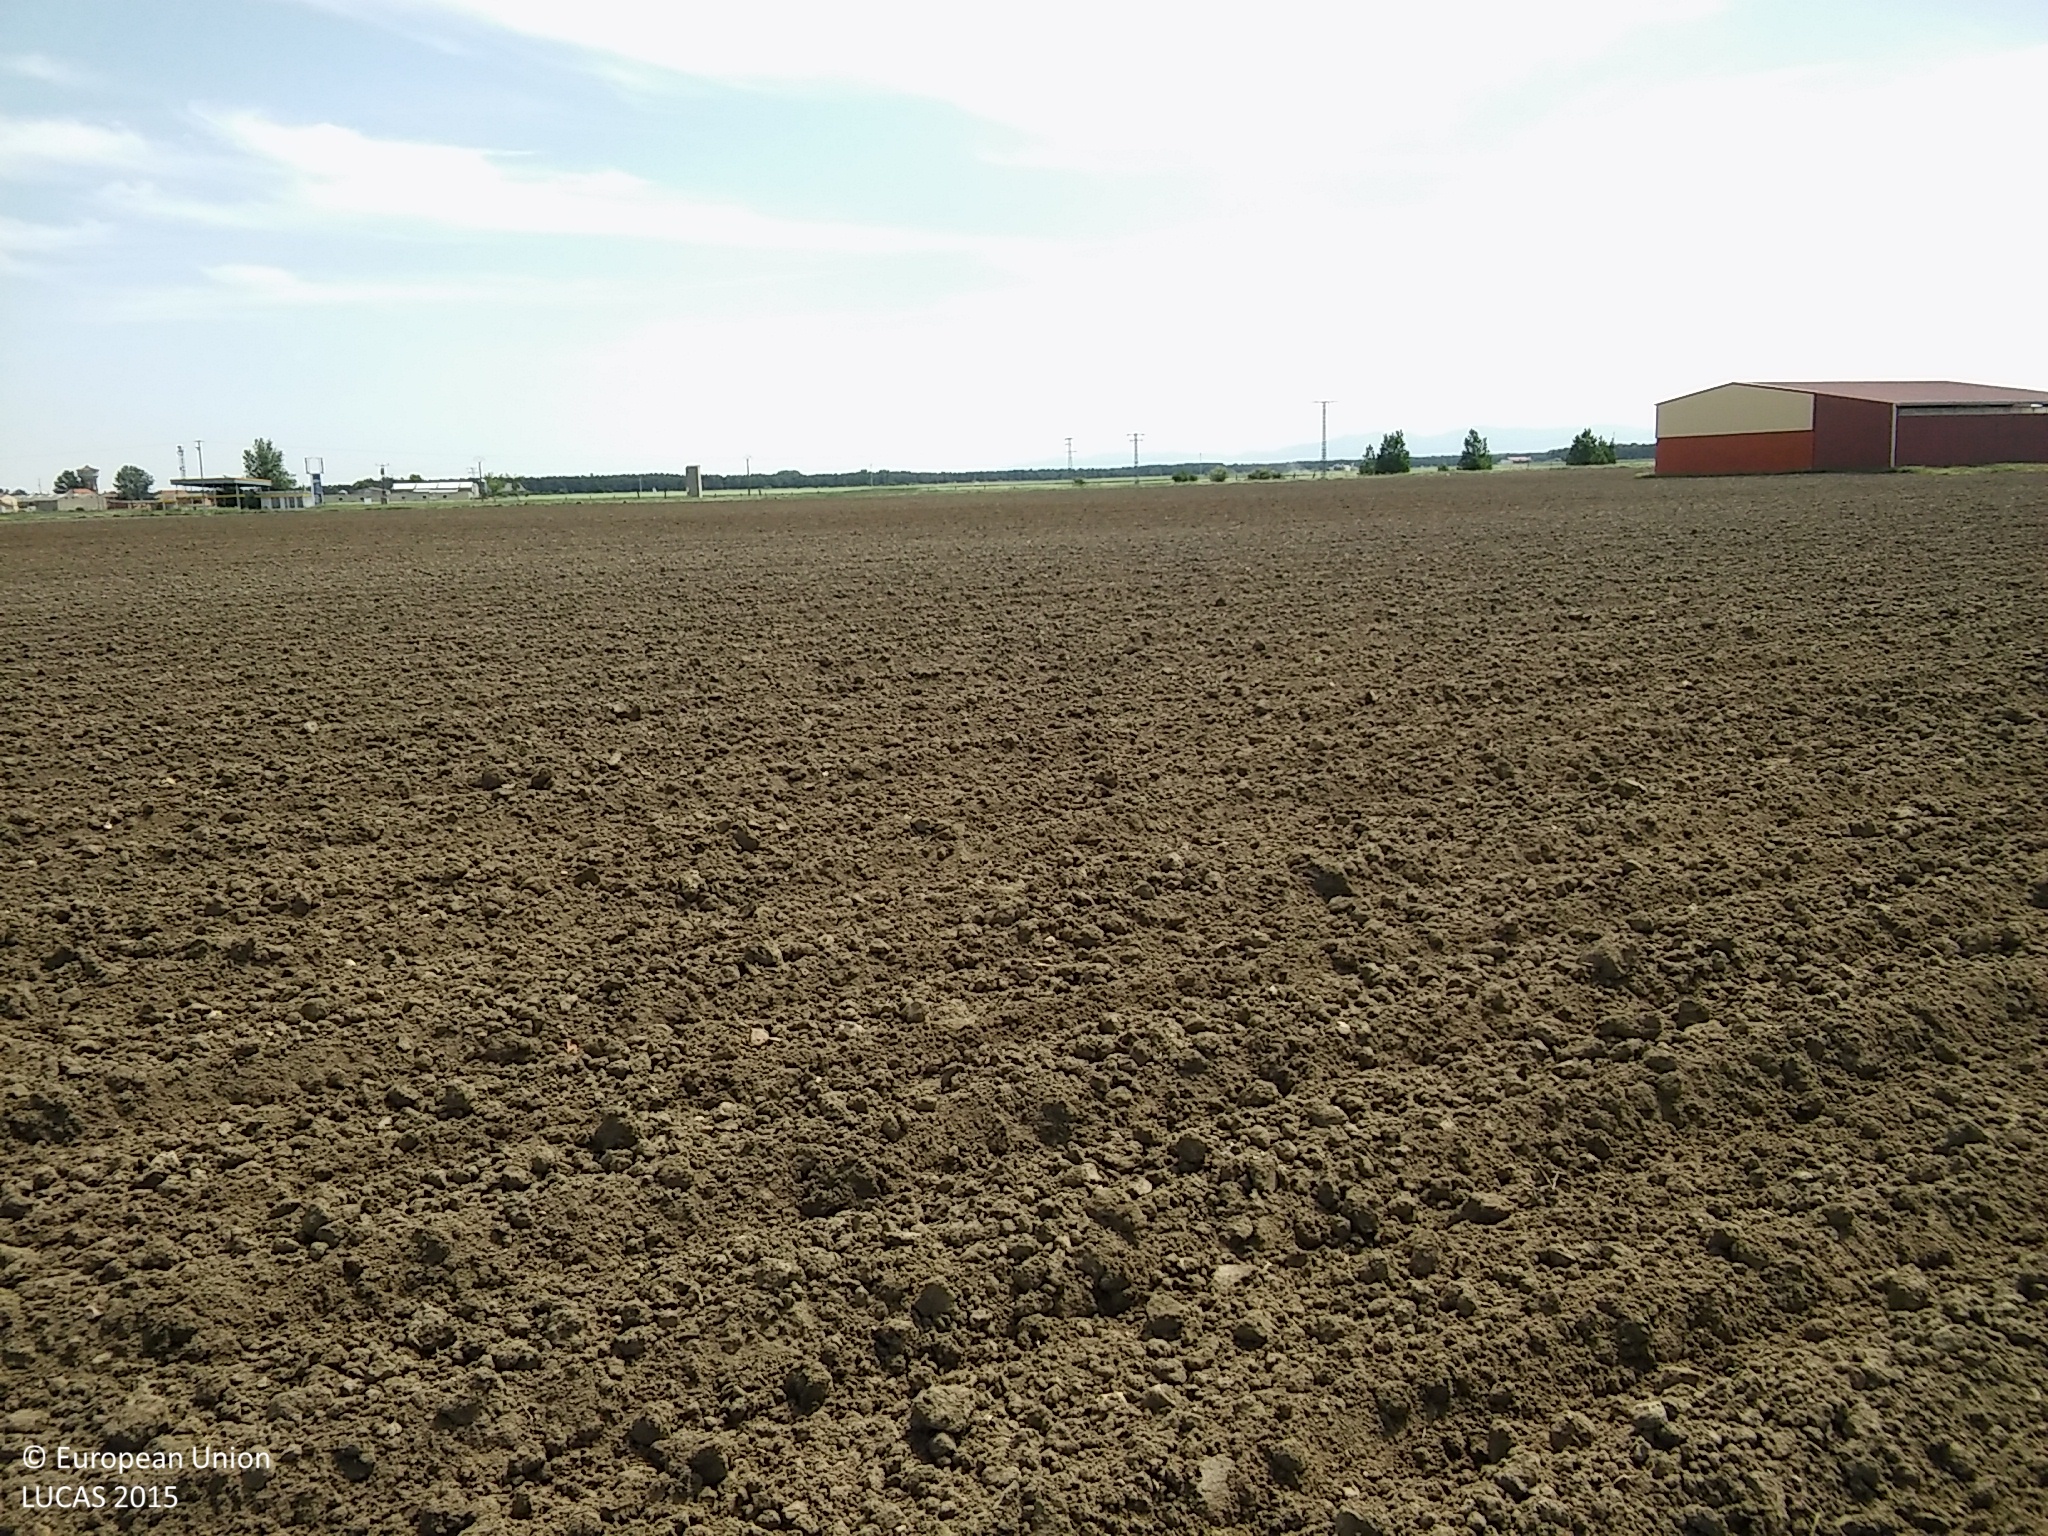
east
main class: Cropland
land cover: Sunflower
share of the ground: < 10 %
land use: Agriculture (excluding fallow land and kitchen gardens)
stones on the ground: < 10 %
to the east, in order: Sunflower
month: May
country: ES
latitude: 41.2202
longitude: -4.1171
